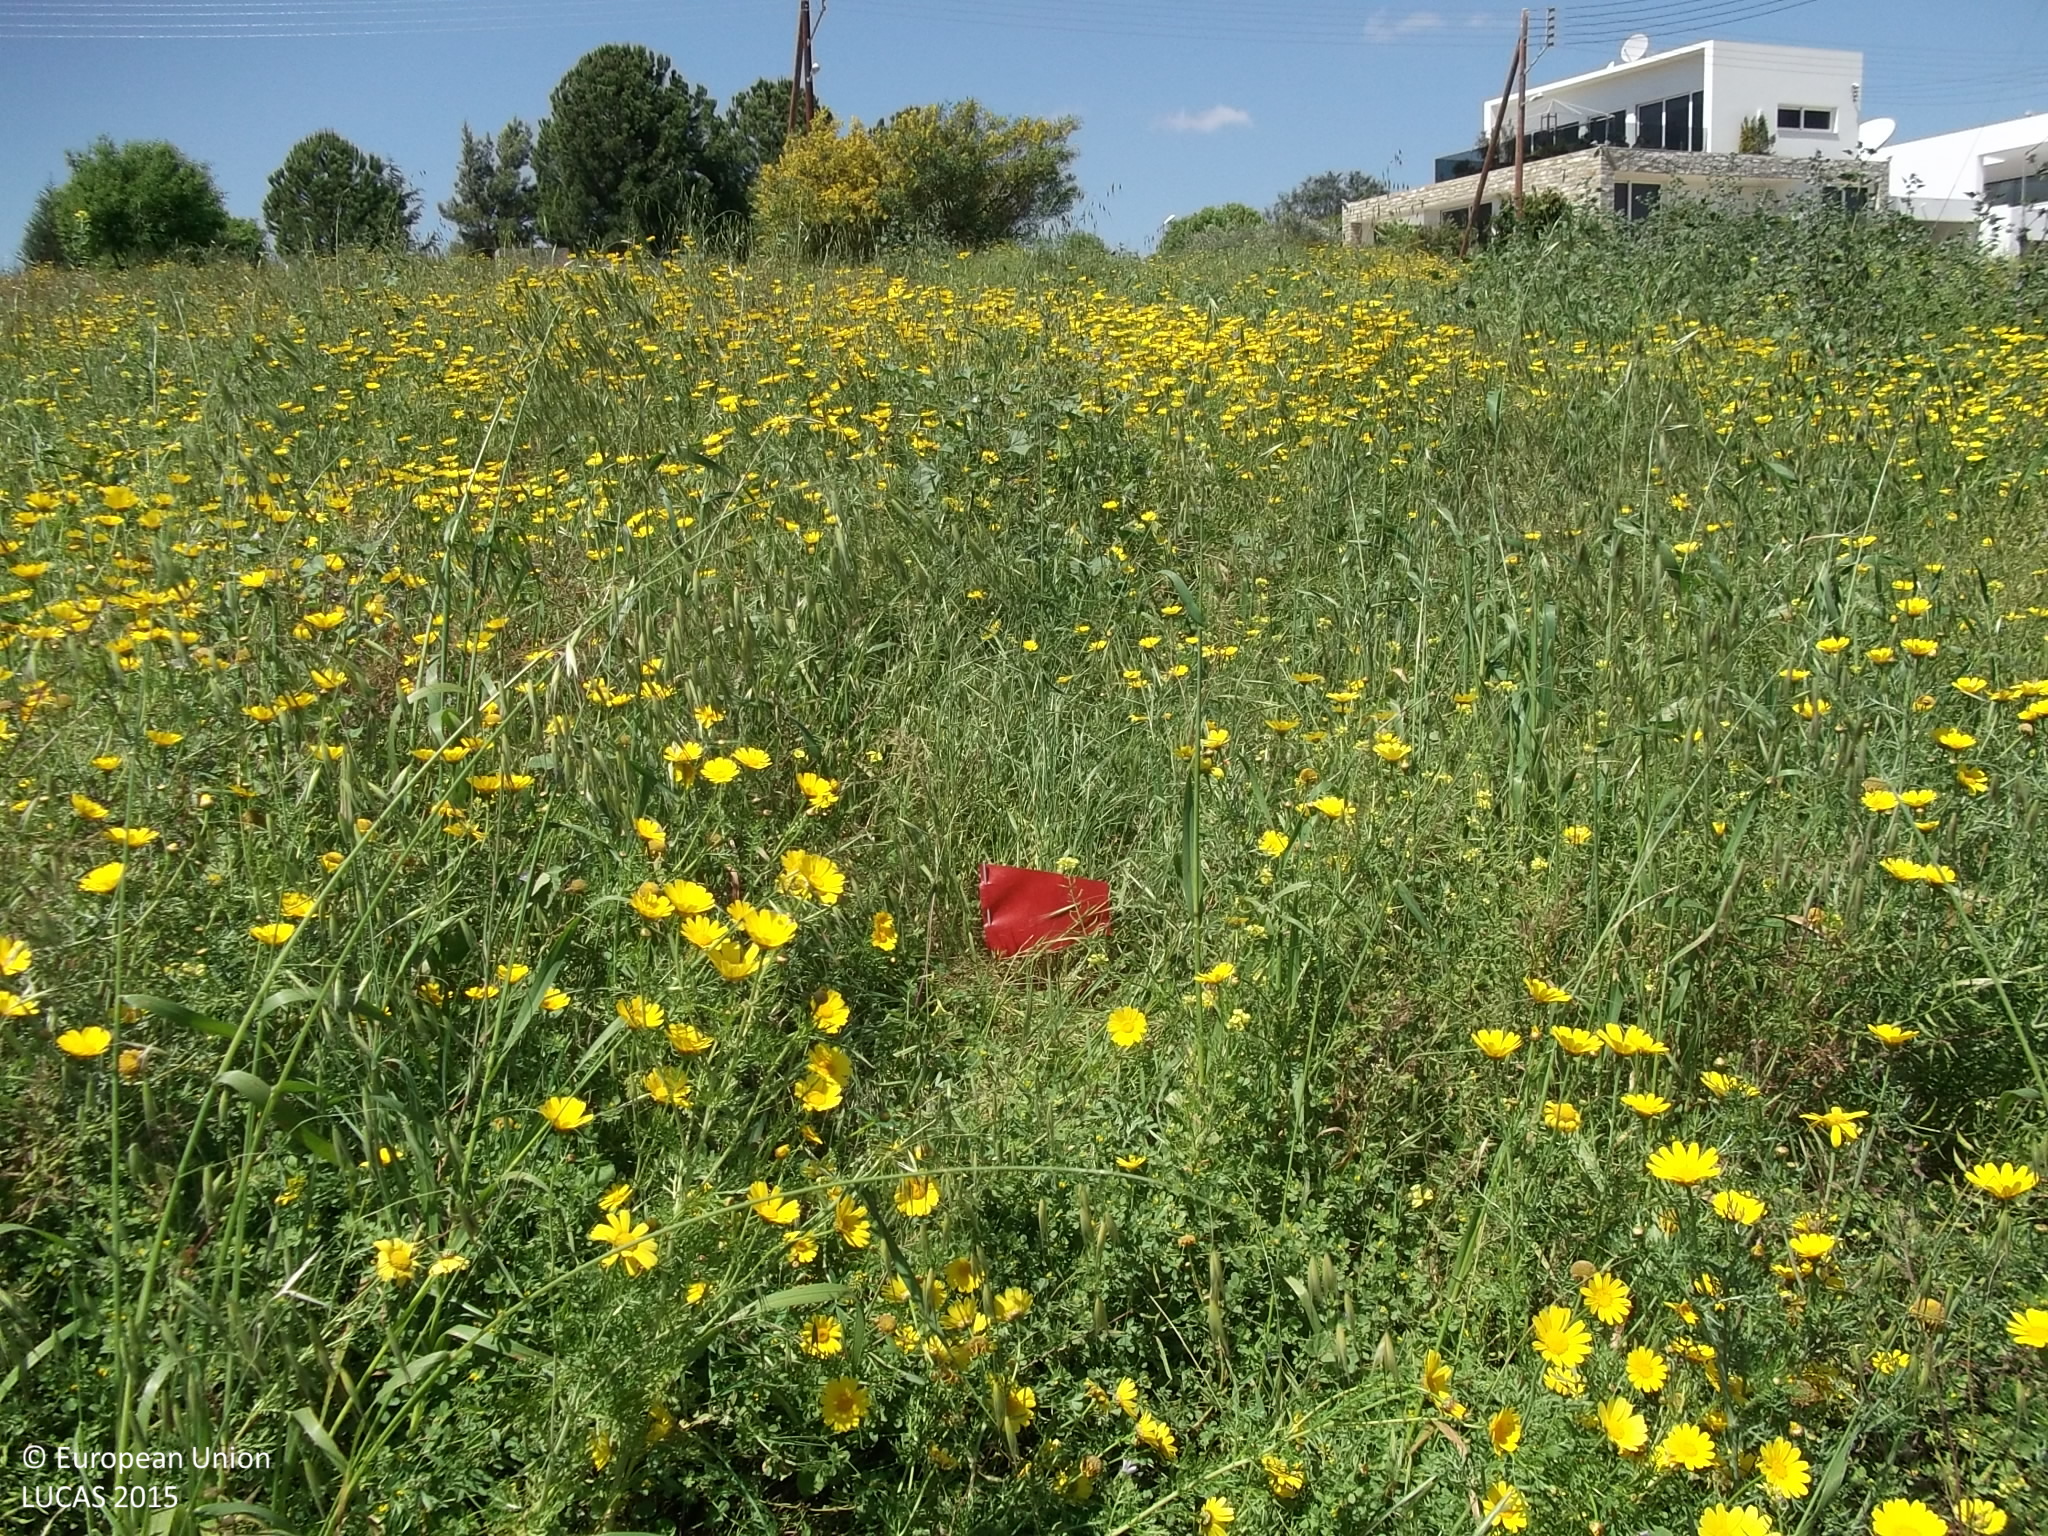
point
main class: Grassland
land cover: Spontaneously vegetated surfaces
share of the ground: > 75 %
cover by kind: herbaceous plants 100 %
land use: Residential
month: April
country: CY
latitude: 34.8534
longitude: 33.4961
